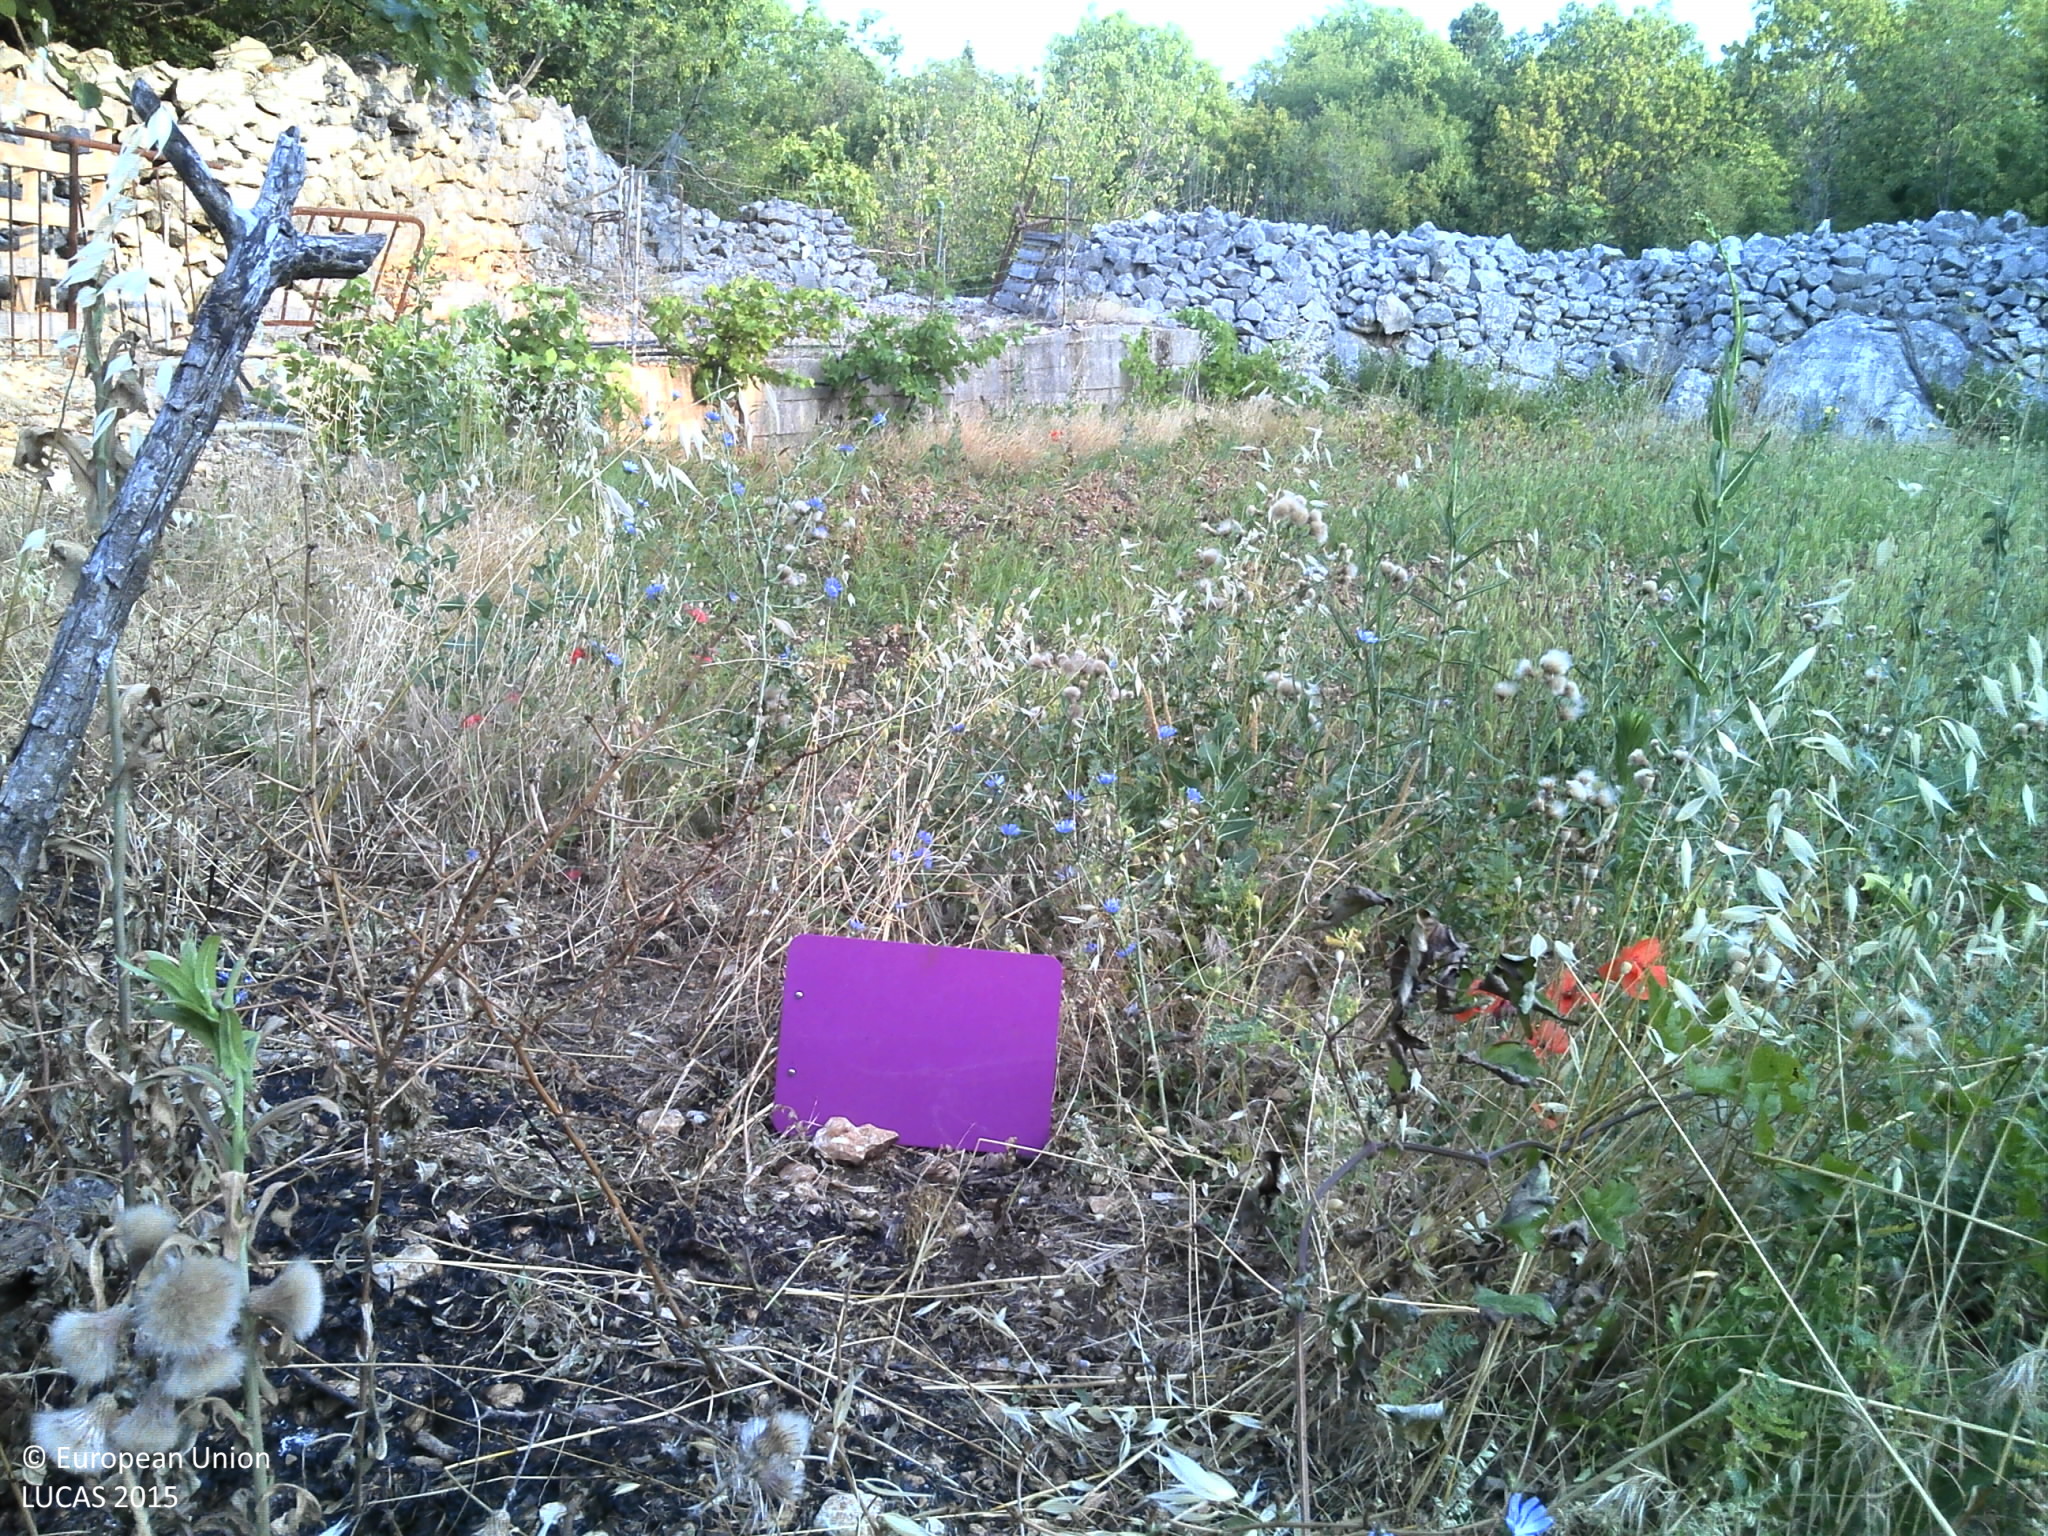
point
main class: Grassland
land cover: Grassland without tree/shrub cover
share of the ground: > 75 %
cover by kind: herbaceous plants 90 %, shrubs 5 %, consolidated bare surface 5 %
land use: Agriculture (excluding fallow land and kitchen gardens)
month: July
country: HR
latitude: 43.4331
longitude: 16.8970
